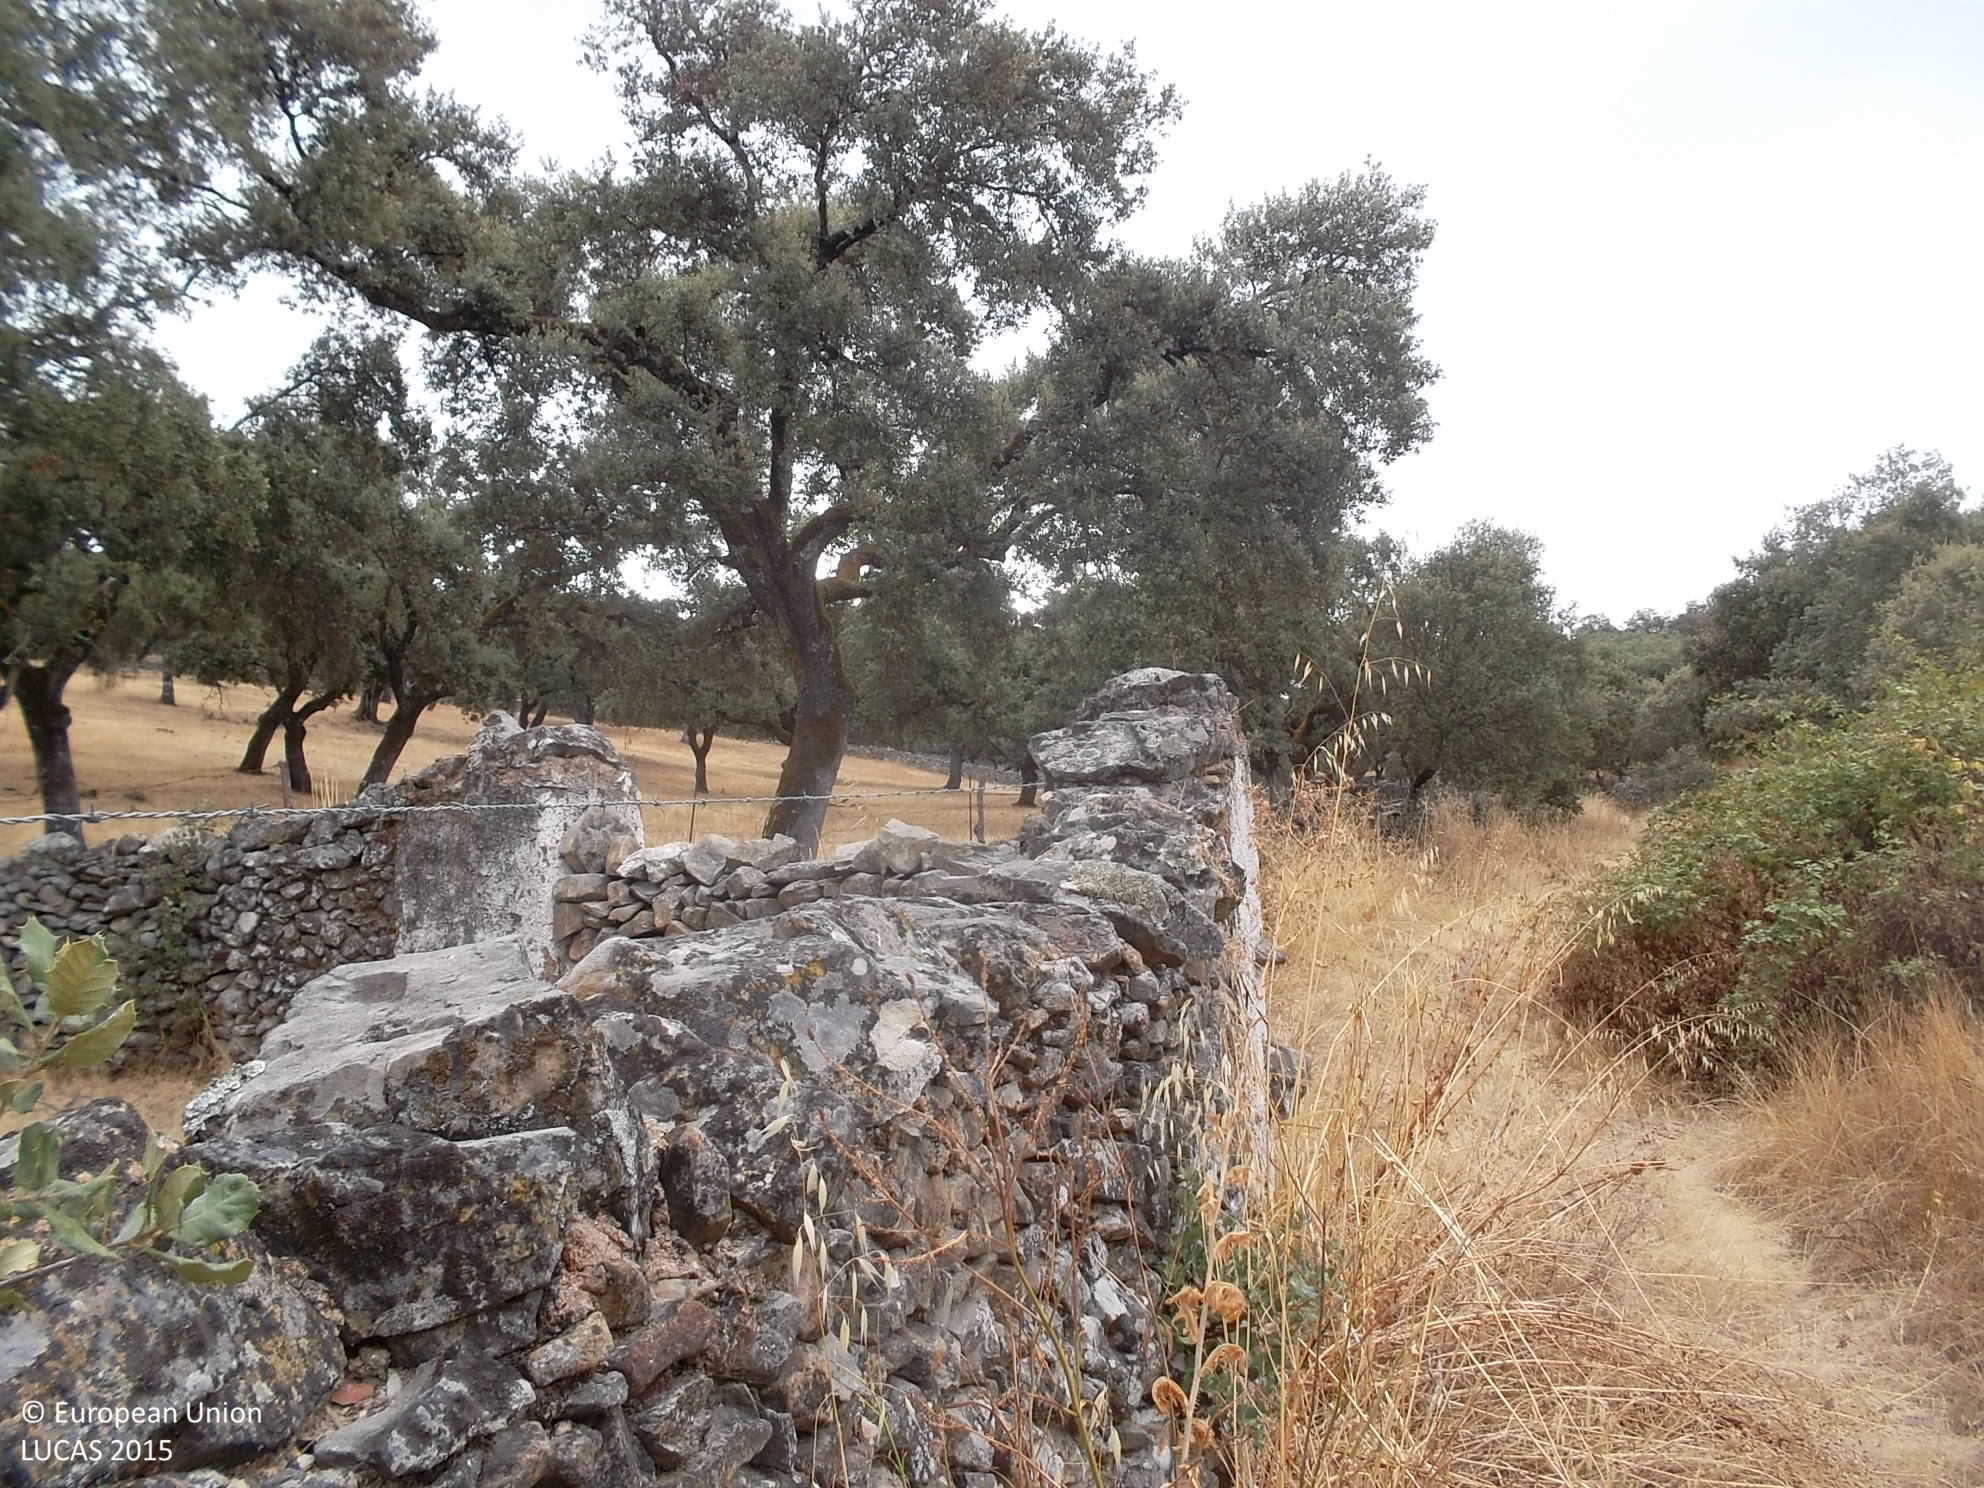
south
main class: Woodland
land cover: Broadleaved woodland
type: broadleaved evergreen forest
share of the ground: 50 - 75 %
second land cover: Grassland without tree/shrub cover
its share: > 75 %
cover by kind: broadleaved forest trees 50 %, herbaceous plants 50 %
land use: Forestry
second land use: Agriculture (excluding fallow land and kitchen gardens)
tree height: > 5 m
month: September
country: ES
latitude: 38.0877
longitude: -6.5912
